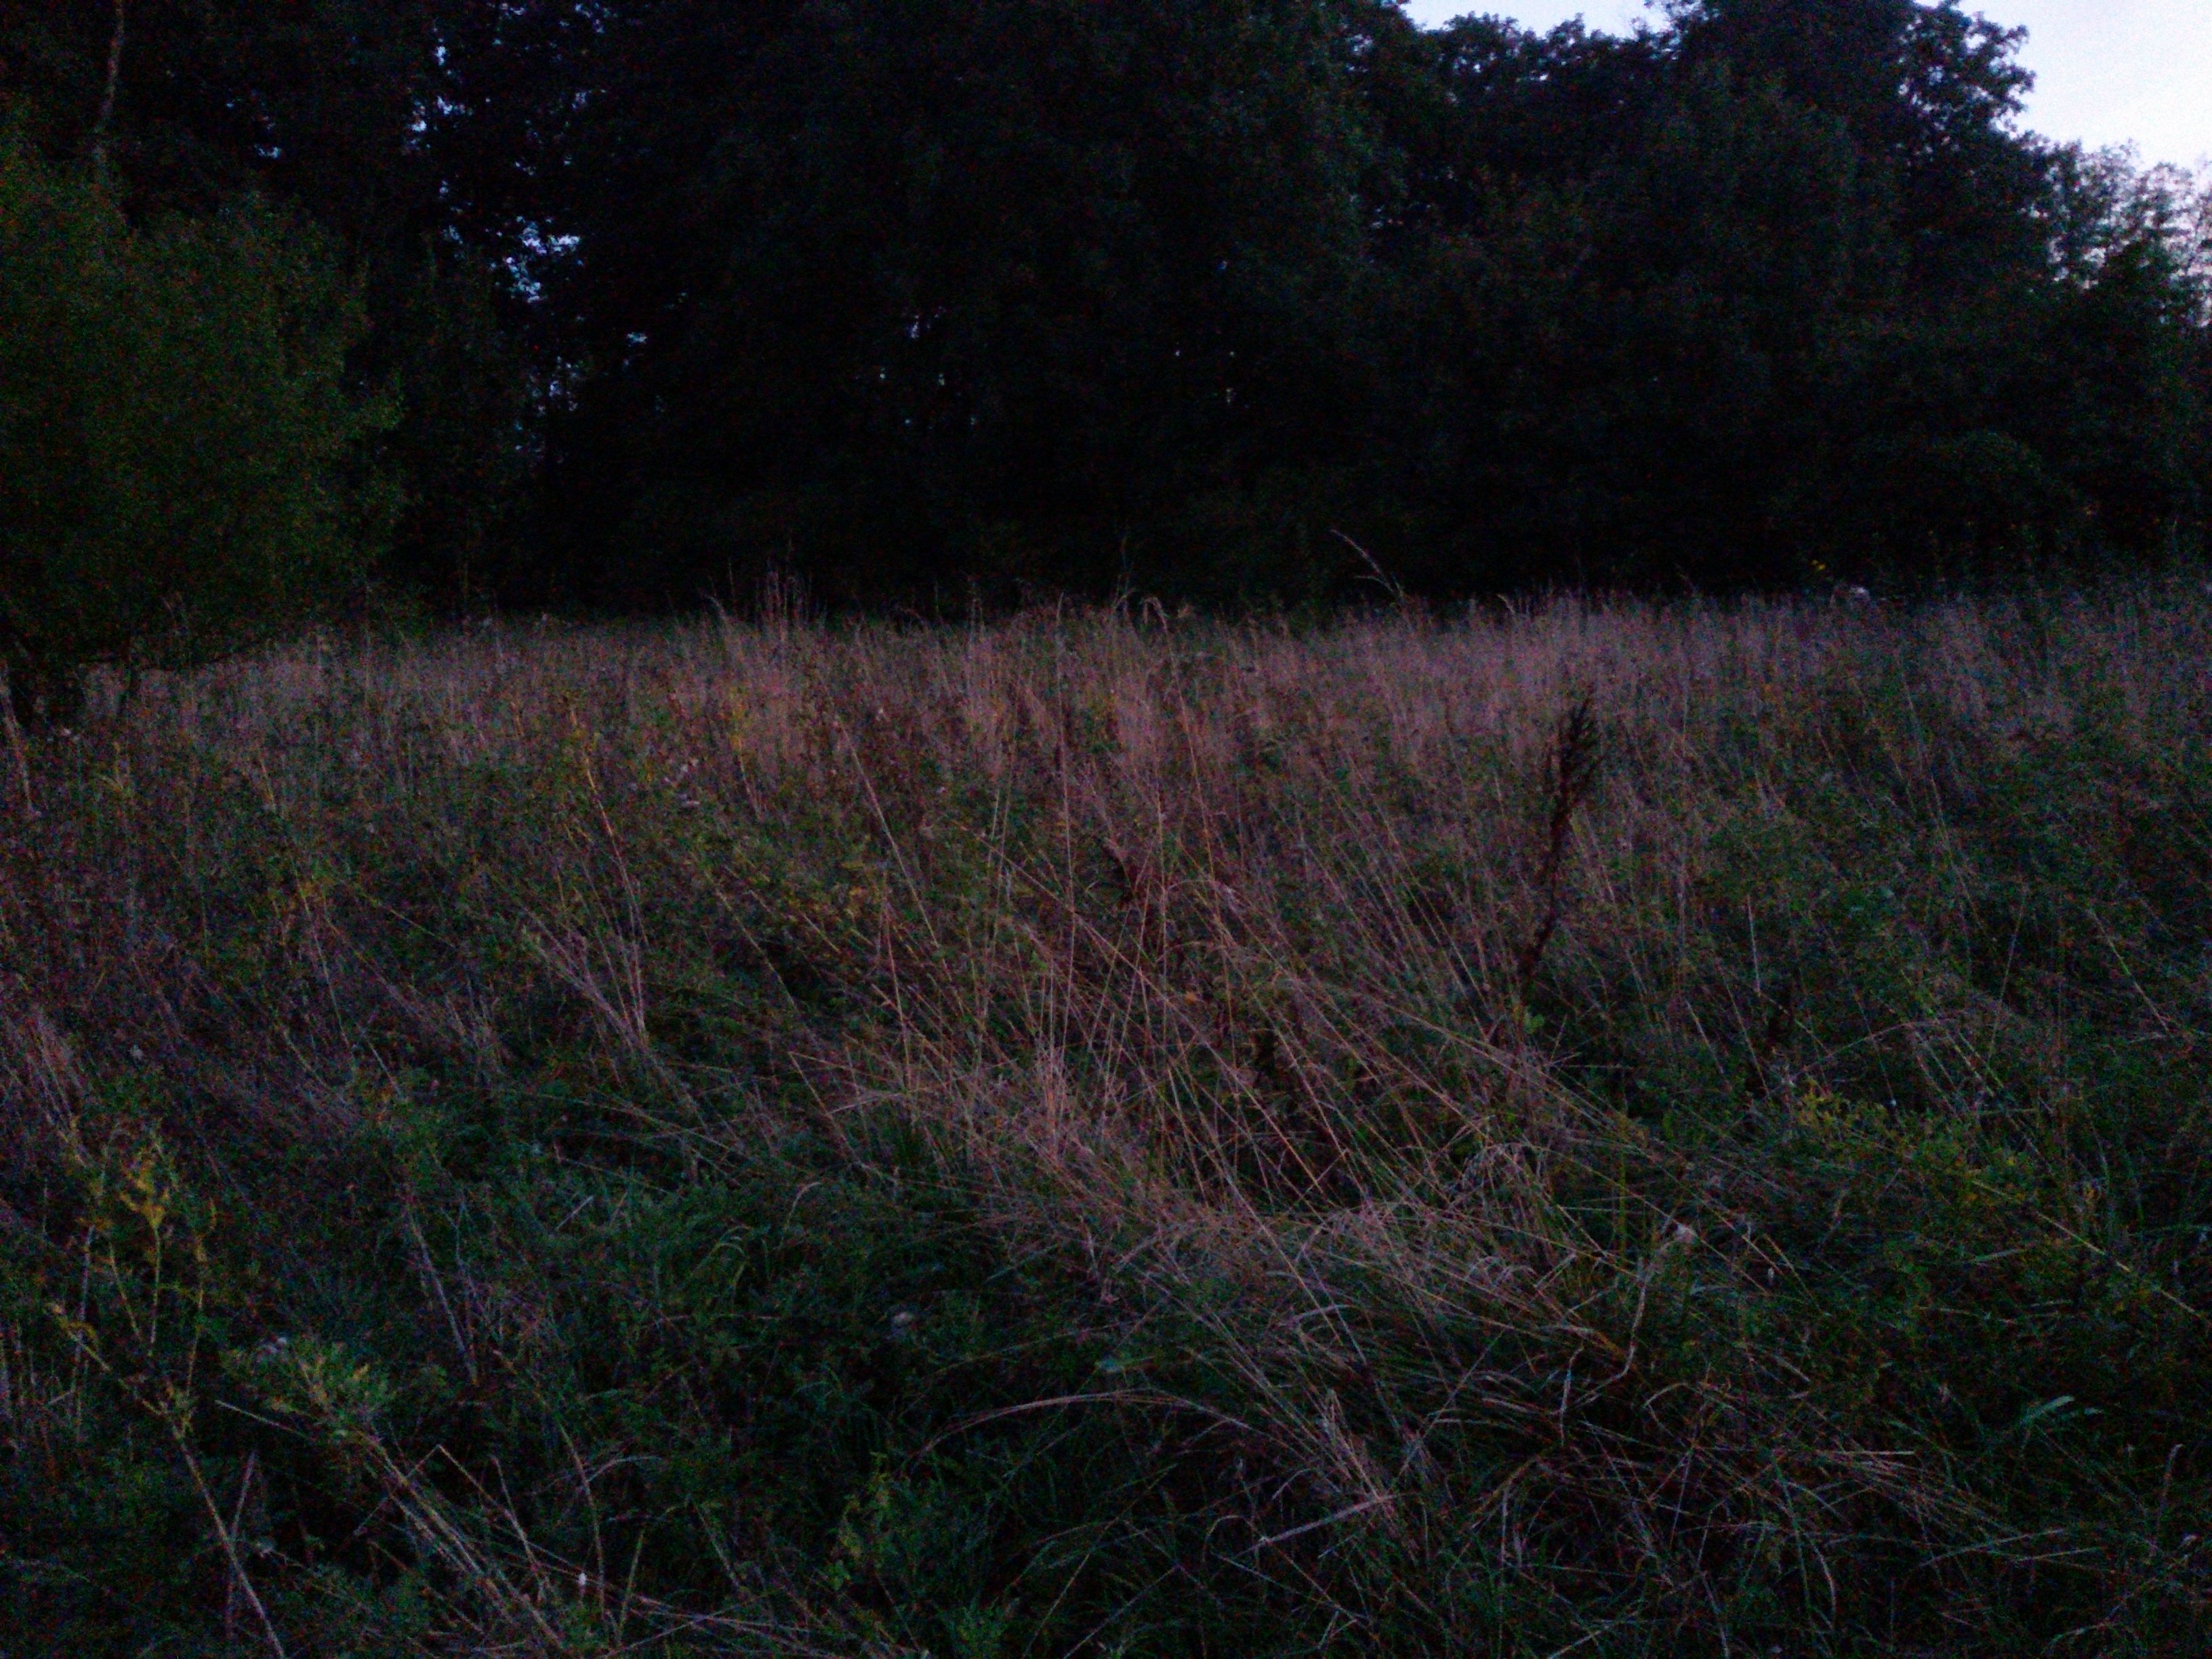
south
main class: Grassland
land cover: Spontaneously vegetated surfaces
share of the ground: > 75 %
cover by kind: herbaceous plants 100 %
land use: Semi-natural and natural areas not in use
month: September
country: PL
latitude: 53.1435
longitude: 17.6224
